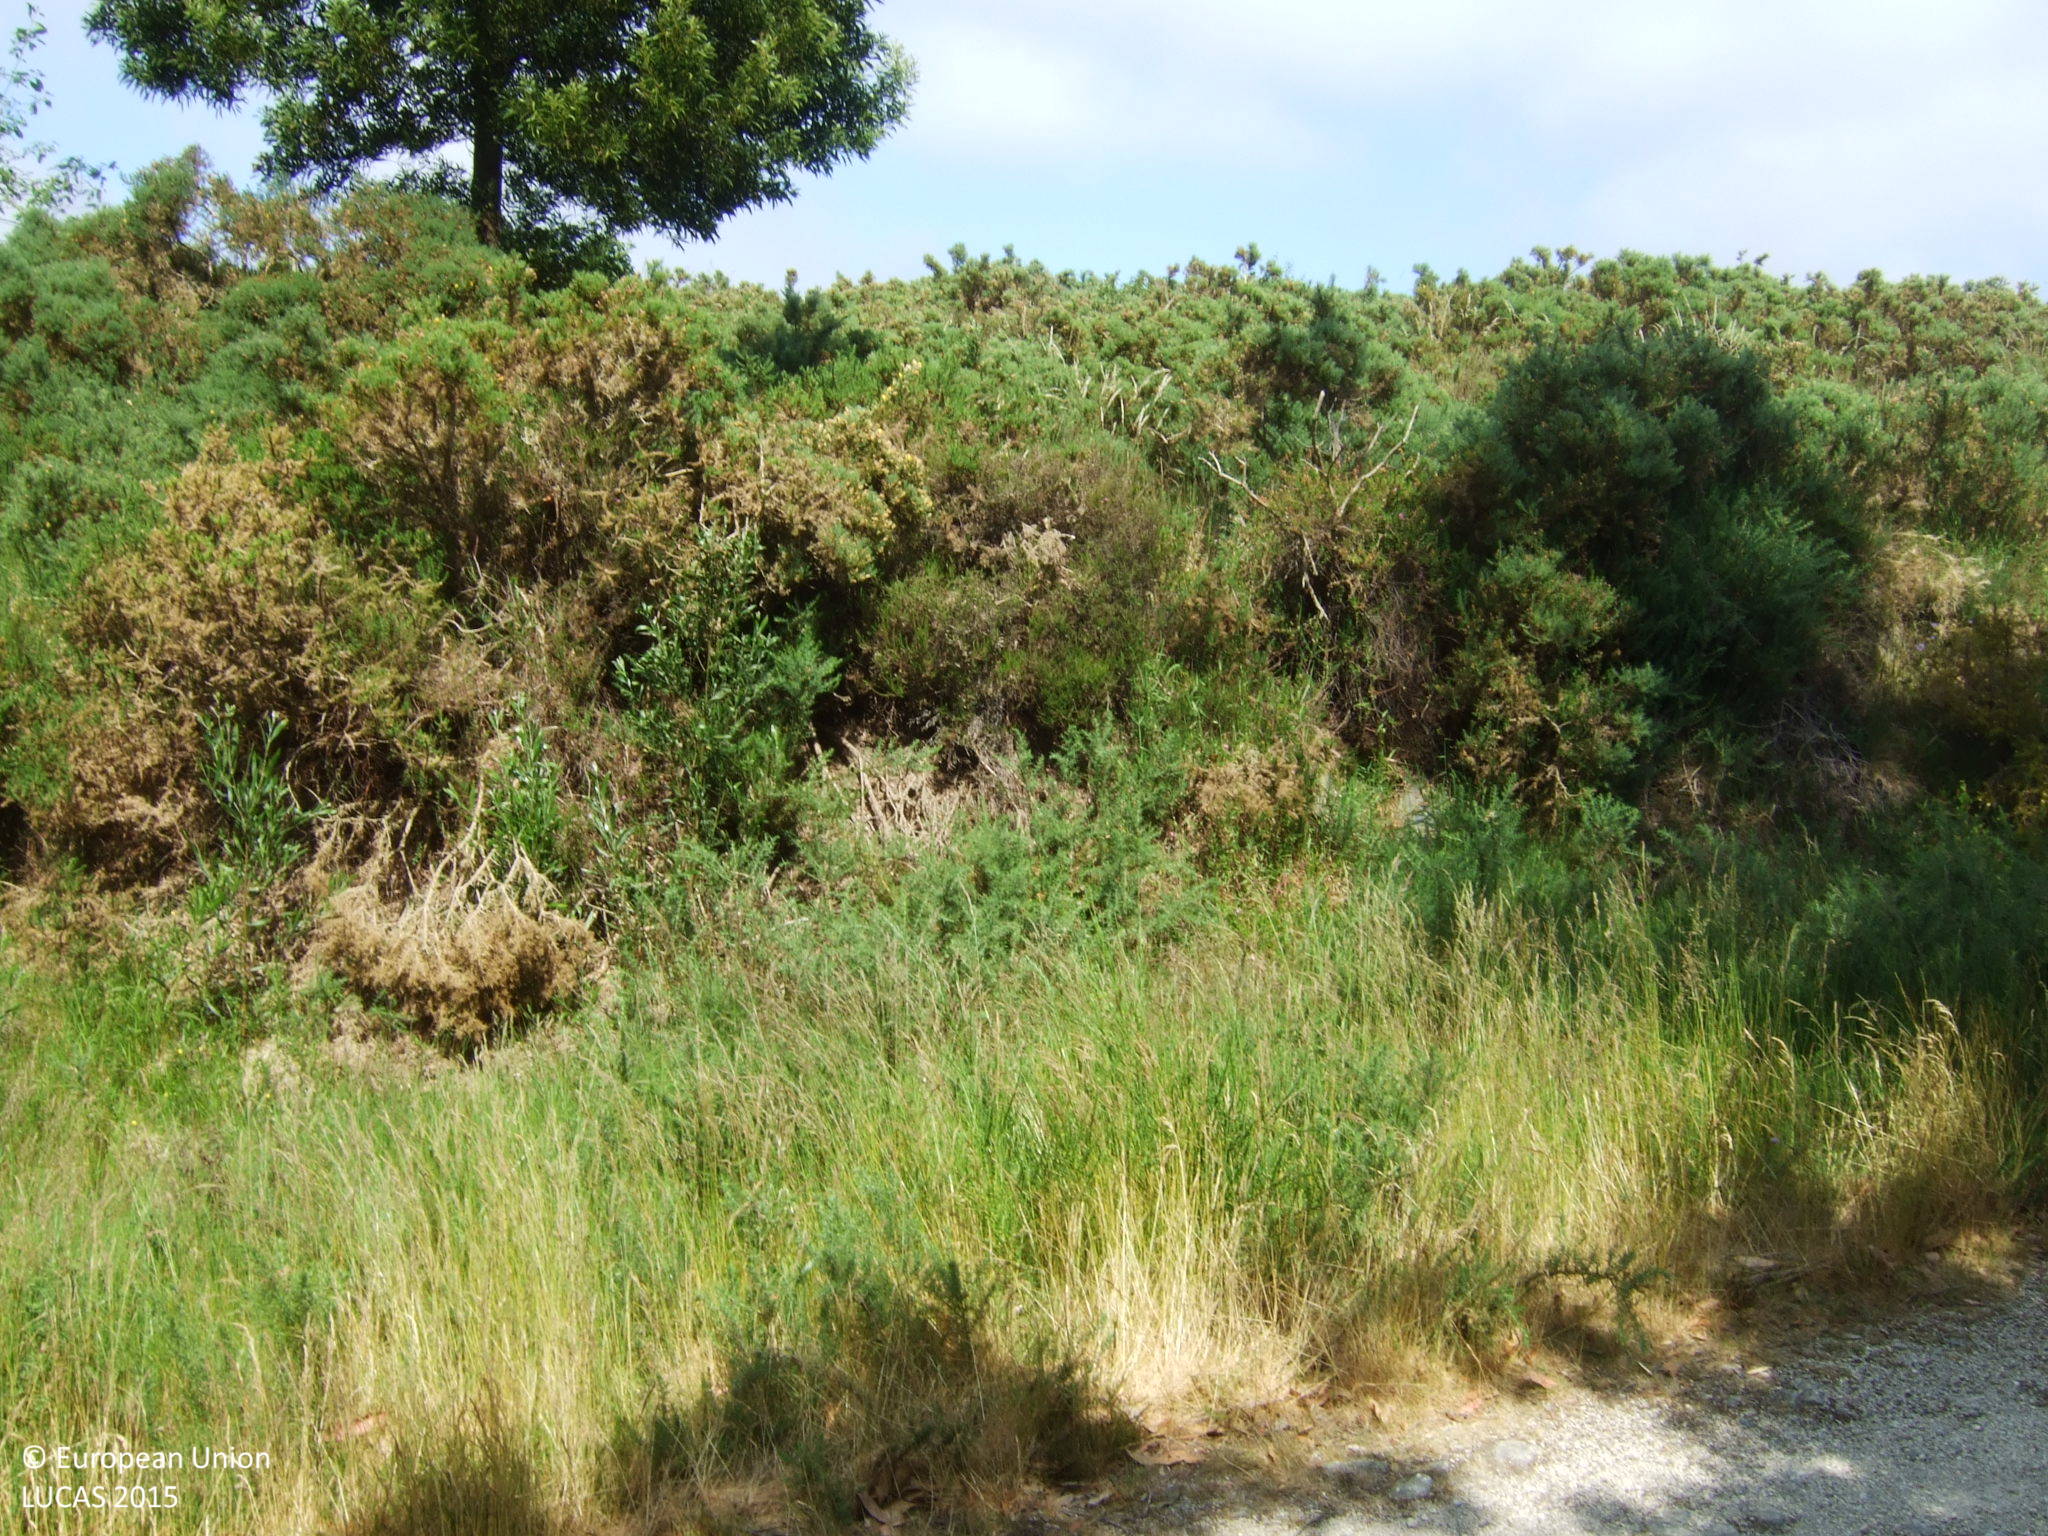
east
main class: Shrubland
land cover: Shrubland without tree cover
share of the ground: > 75 %
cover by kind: shrubs 100 %
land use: Semi-natural and natural areas not in use
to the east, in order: Shrubland without tree cover; Broadleaved woodland; Tracks; Broadleaved woodland; Tracks; Broadleaved woodland
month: June
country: ES
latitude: 43.4774
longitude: -7.8061
